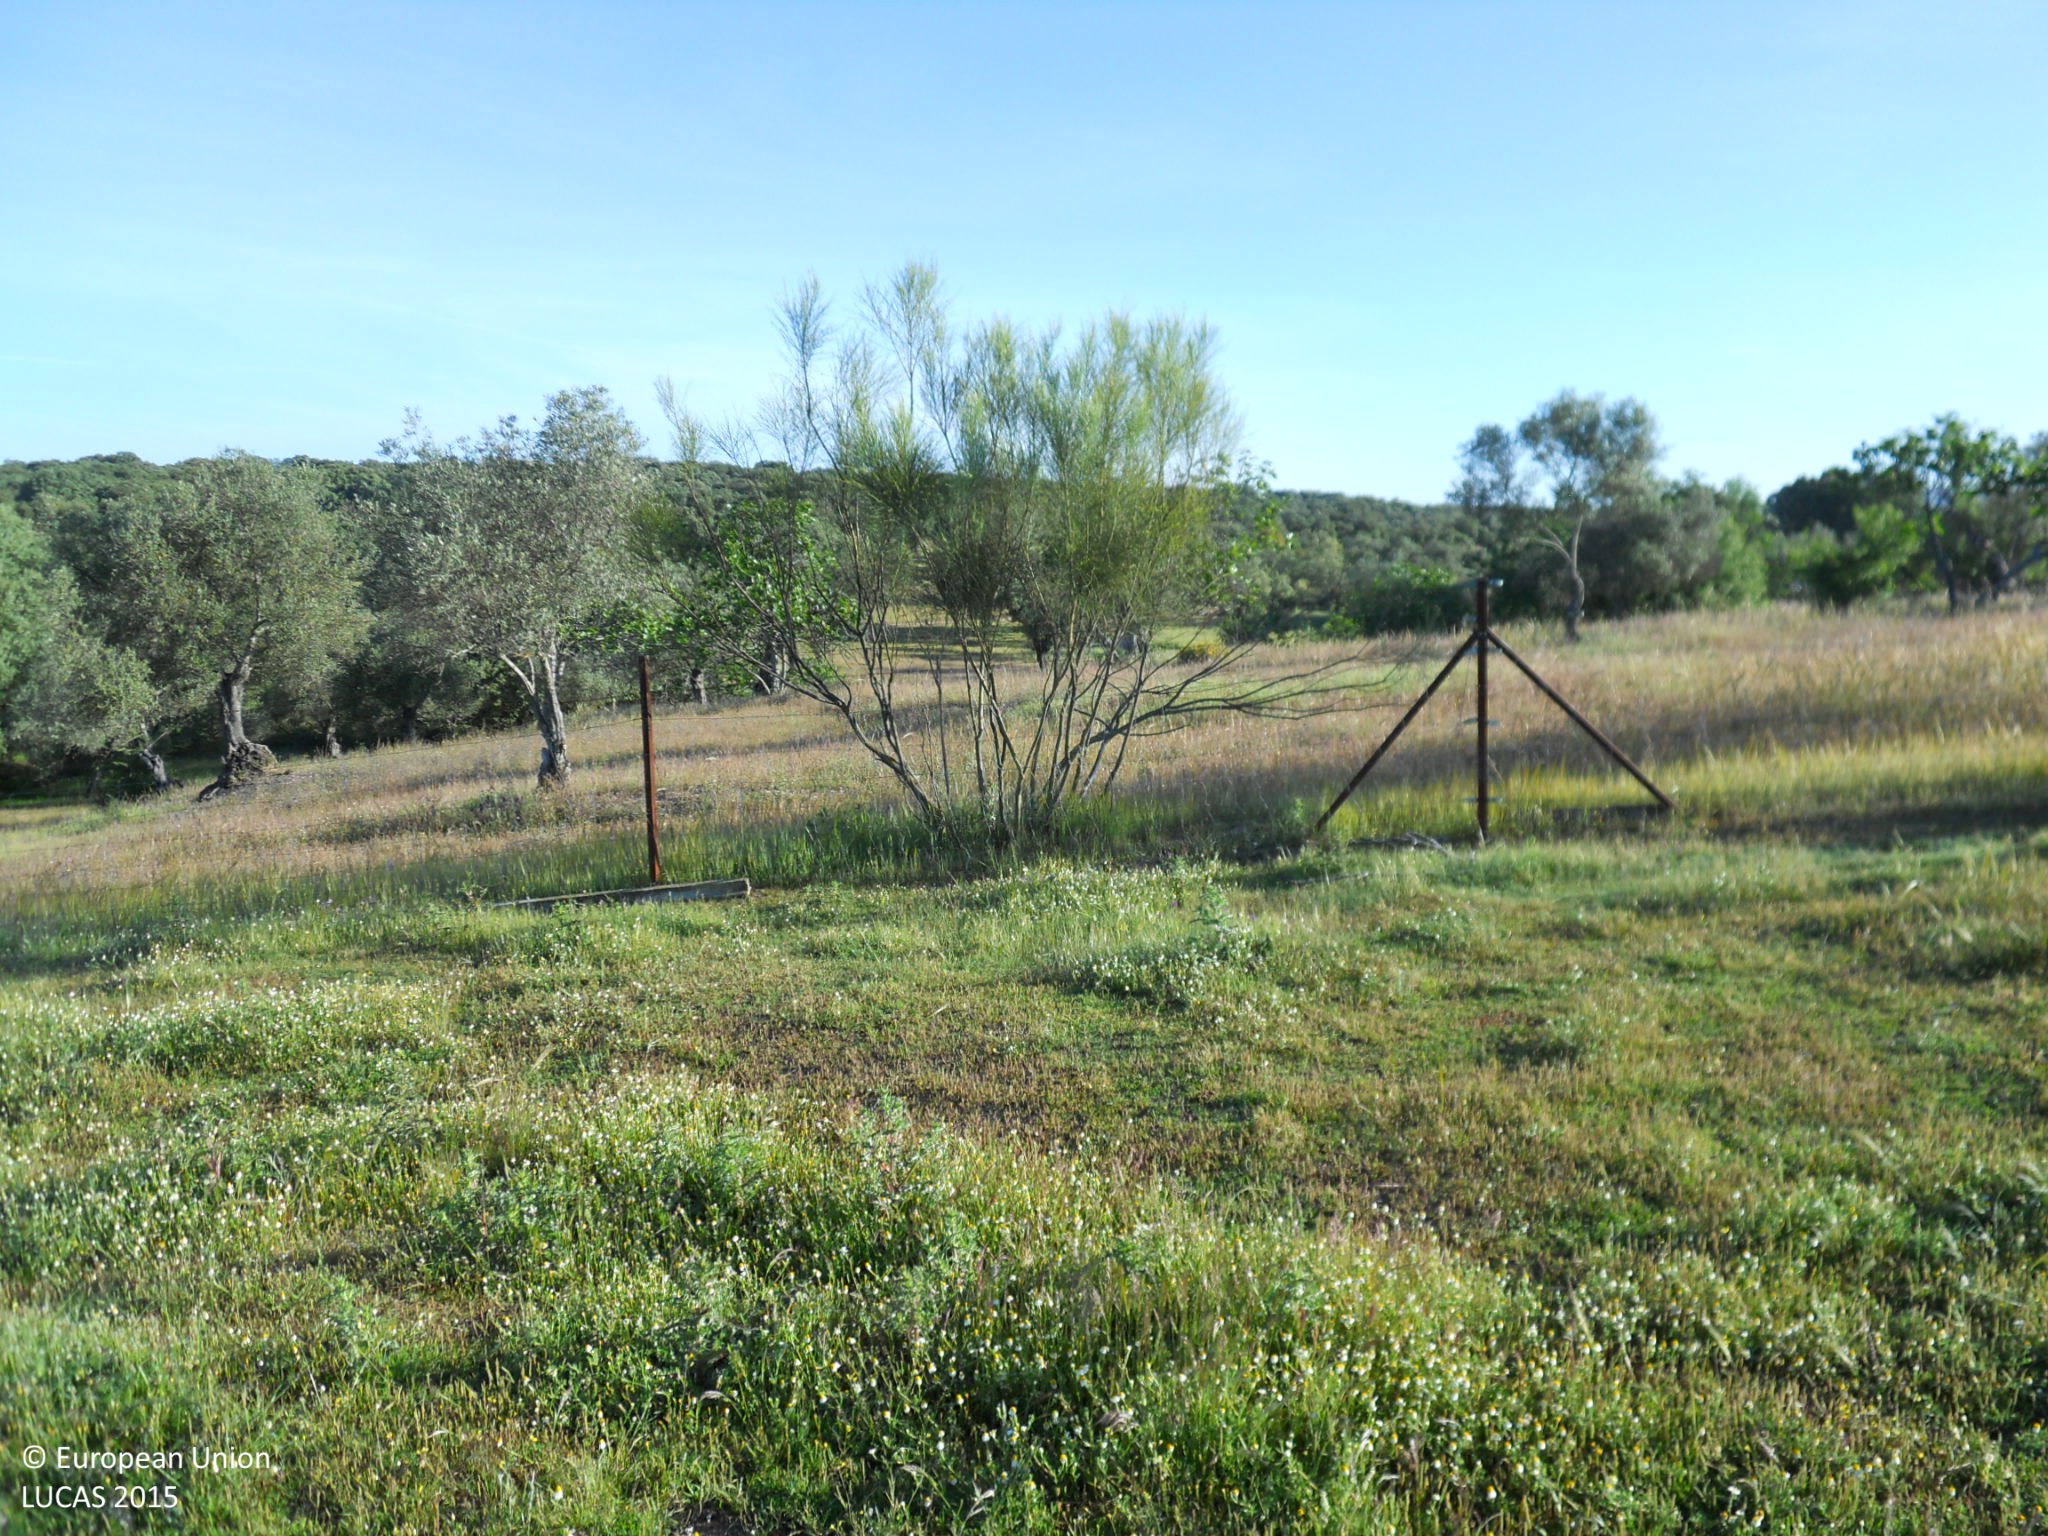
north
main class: Grassland
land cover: Grassland with sparse tree/shrub cover
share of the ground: > 75 %
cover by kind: herbaceous plants 95 %, broadleaved forest trees 5 %
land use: Agriculture (excluding fallow land and kitchen gardens)
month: April
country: ES
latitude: 39.1112
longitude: -6.8521
